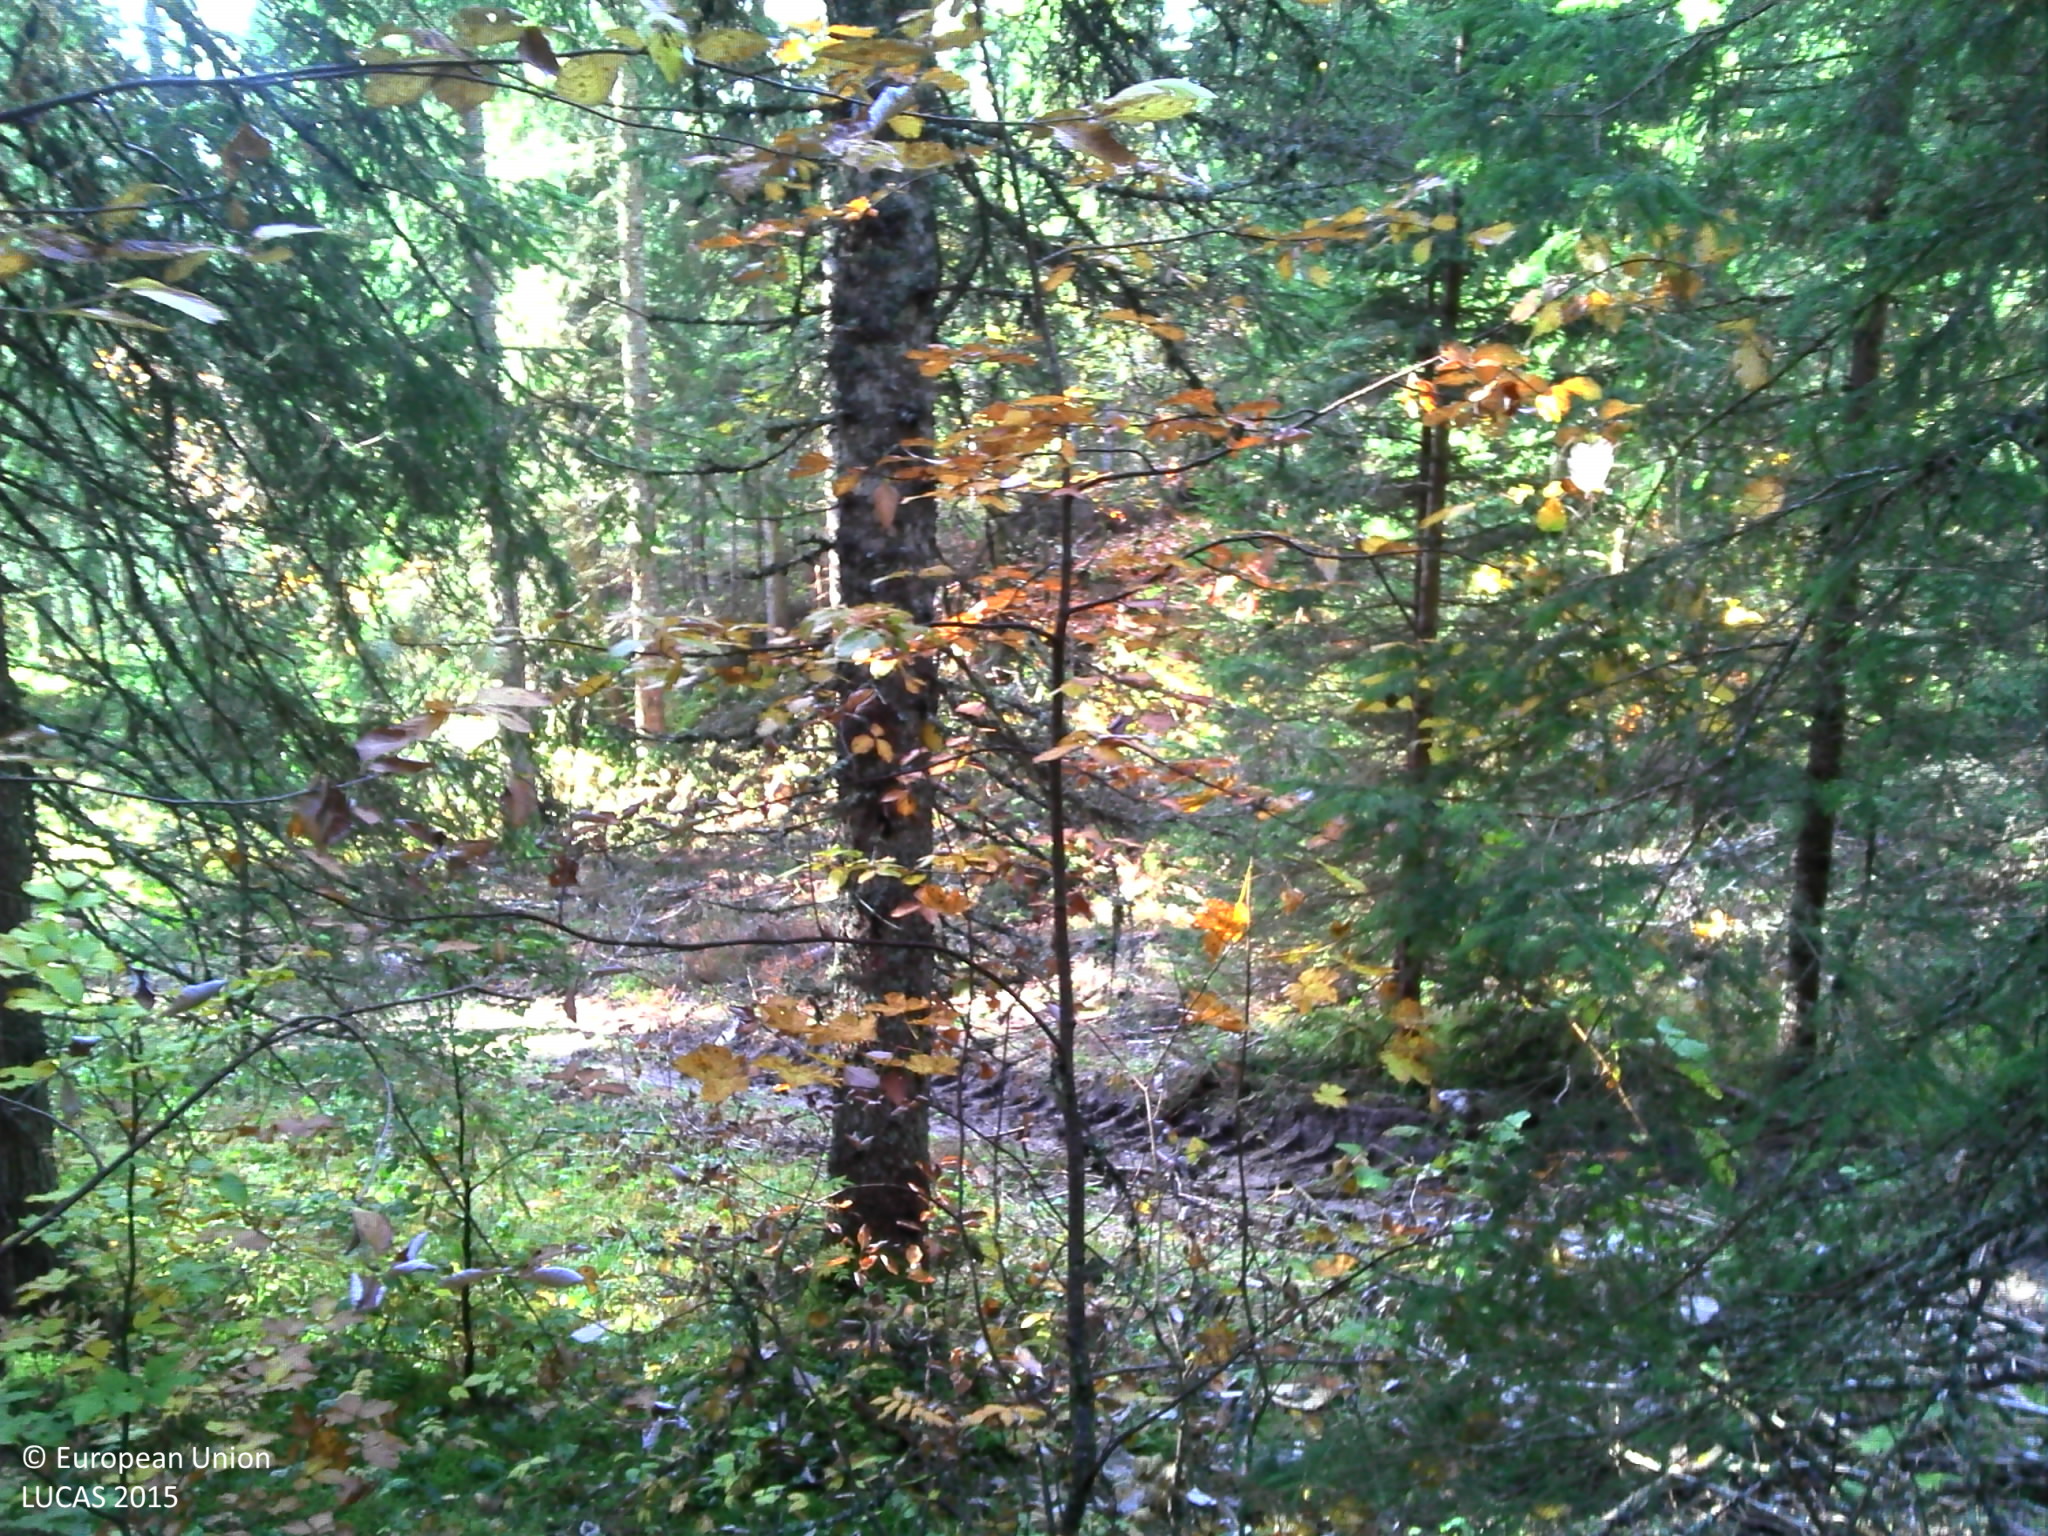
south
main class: Woodland
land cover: Spruce dominated coniferous woodland
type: hemiboreal forest and nemoral coniferous forest and mixed broadleaved-coniferous forest
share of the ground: > 75 %
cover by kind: coniferous forest trees 75 %, shrubs 10 %, herbaceous plants 10 %, broadleaved forest trees 5 %
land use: Forestry
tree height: > 5 m
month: October
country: FR
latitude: 46.6037
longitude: 6.0732
